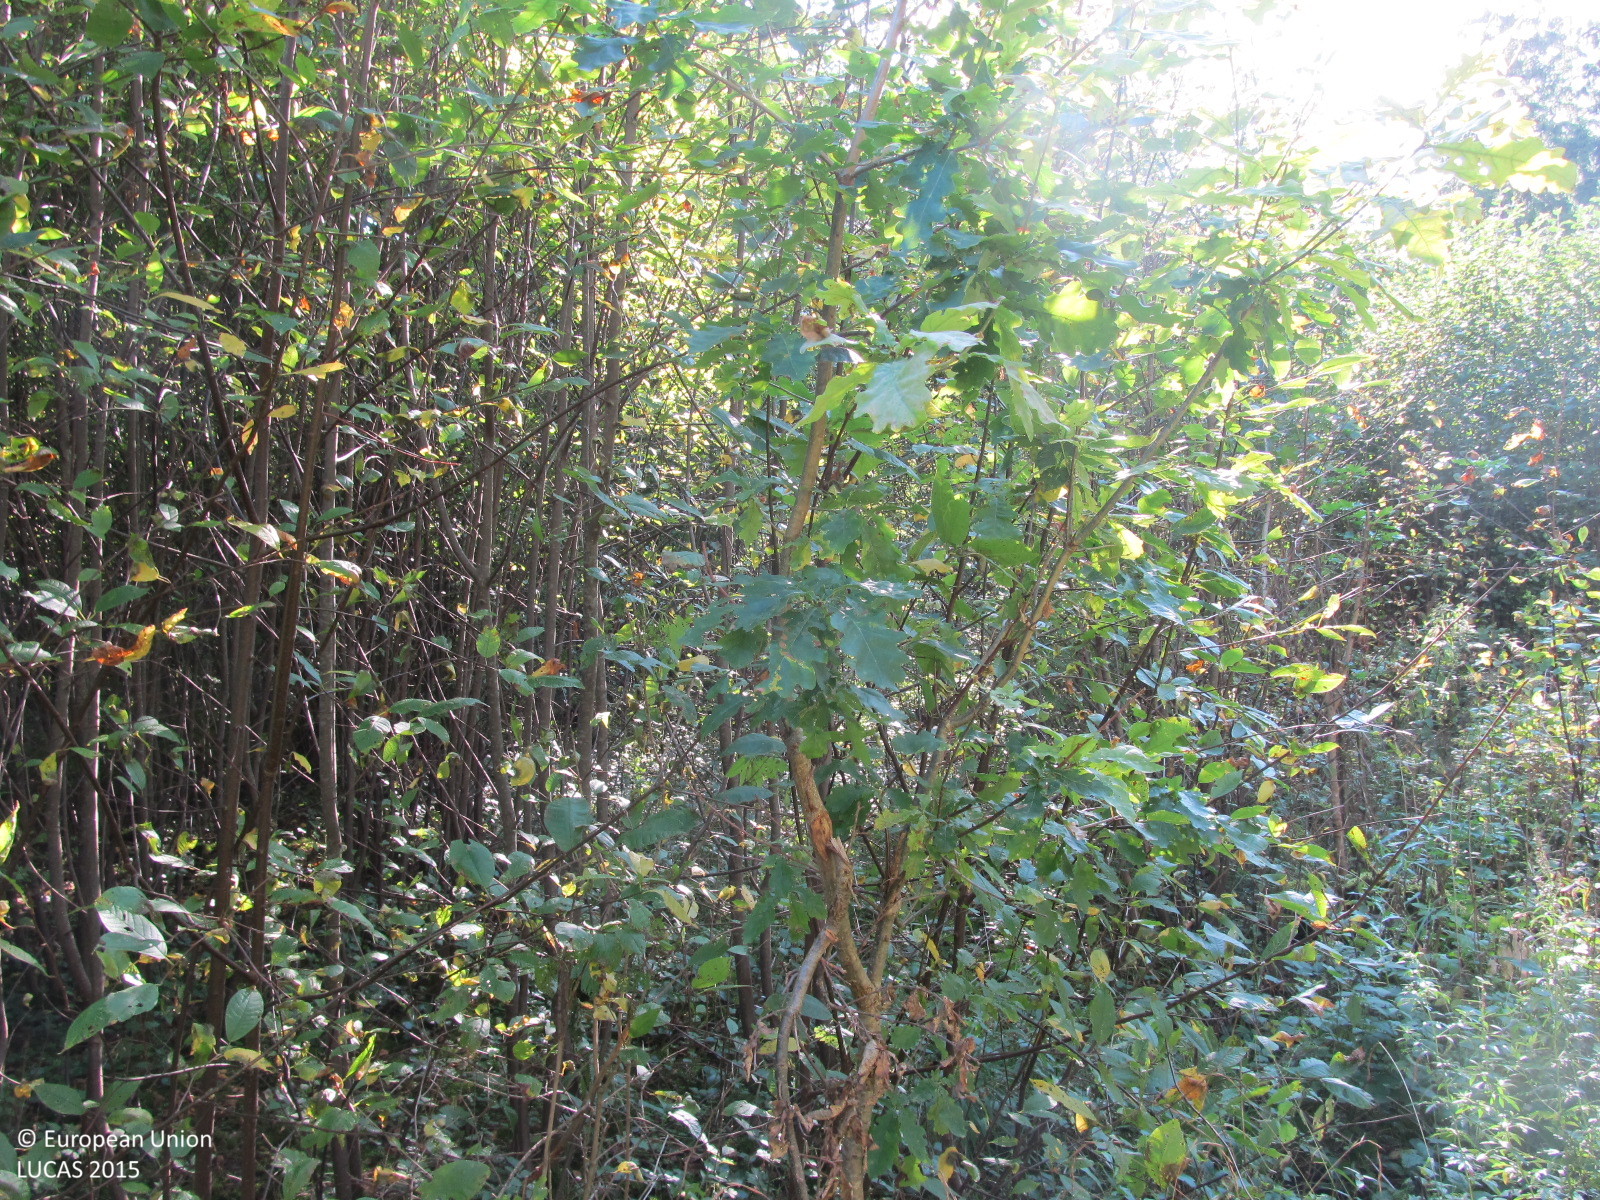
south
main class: Woodland
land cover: Spruce dominated mixed woodland
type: hemiboreal forest and nemoral coniferous forest and mixed broadleaved-coniferous forest
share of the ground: 50 - 75 %
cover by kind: coniferous forest trees 30 %, broadleaved forest trees 30 %, shrubs 20 %, herbaceous plants 20 %
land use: Forestry
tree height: > 5 m
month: September
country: LT
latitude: 56.2417
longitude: 22.9257
